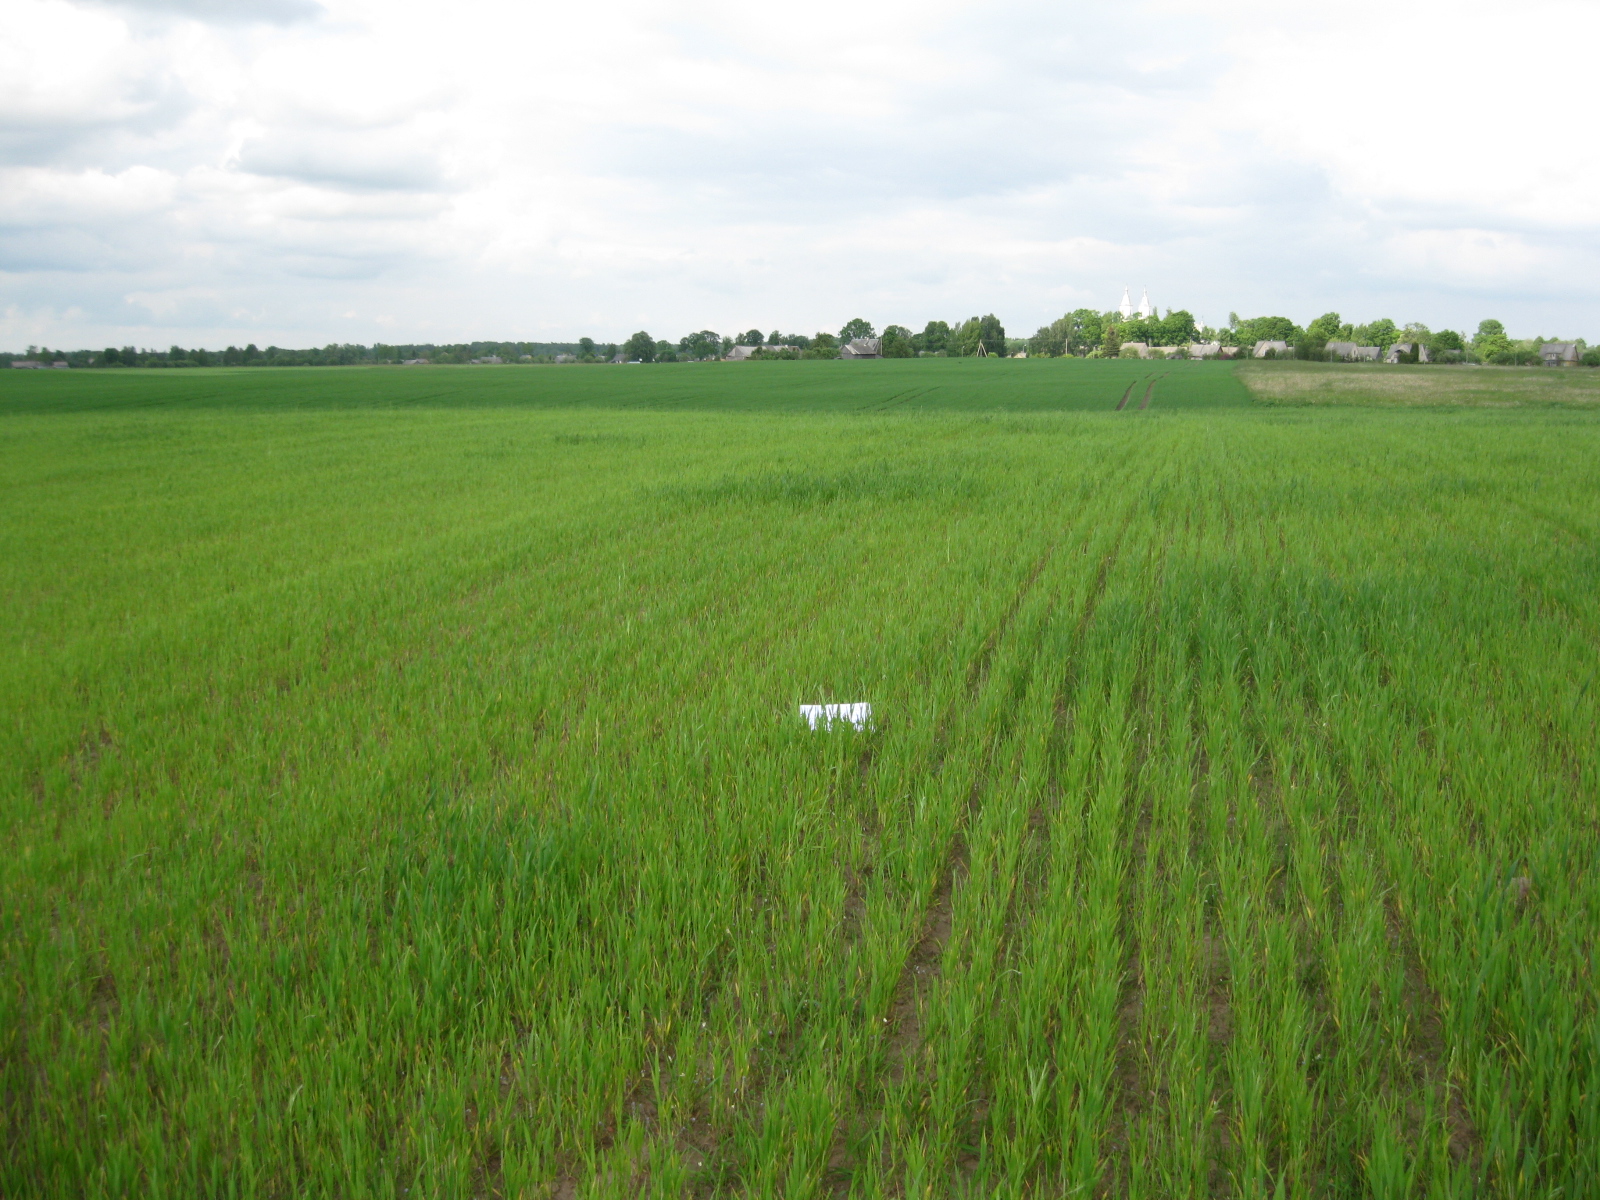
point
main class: Cropland
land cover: Common wheat
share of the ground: > 75 %
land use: Agriculture (excluding fallow land and kitchen gardens)
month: May
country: LT
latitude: 55.7291
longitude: 24.7709
